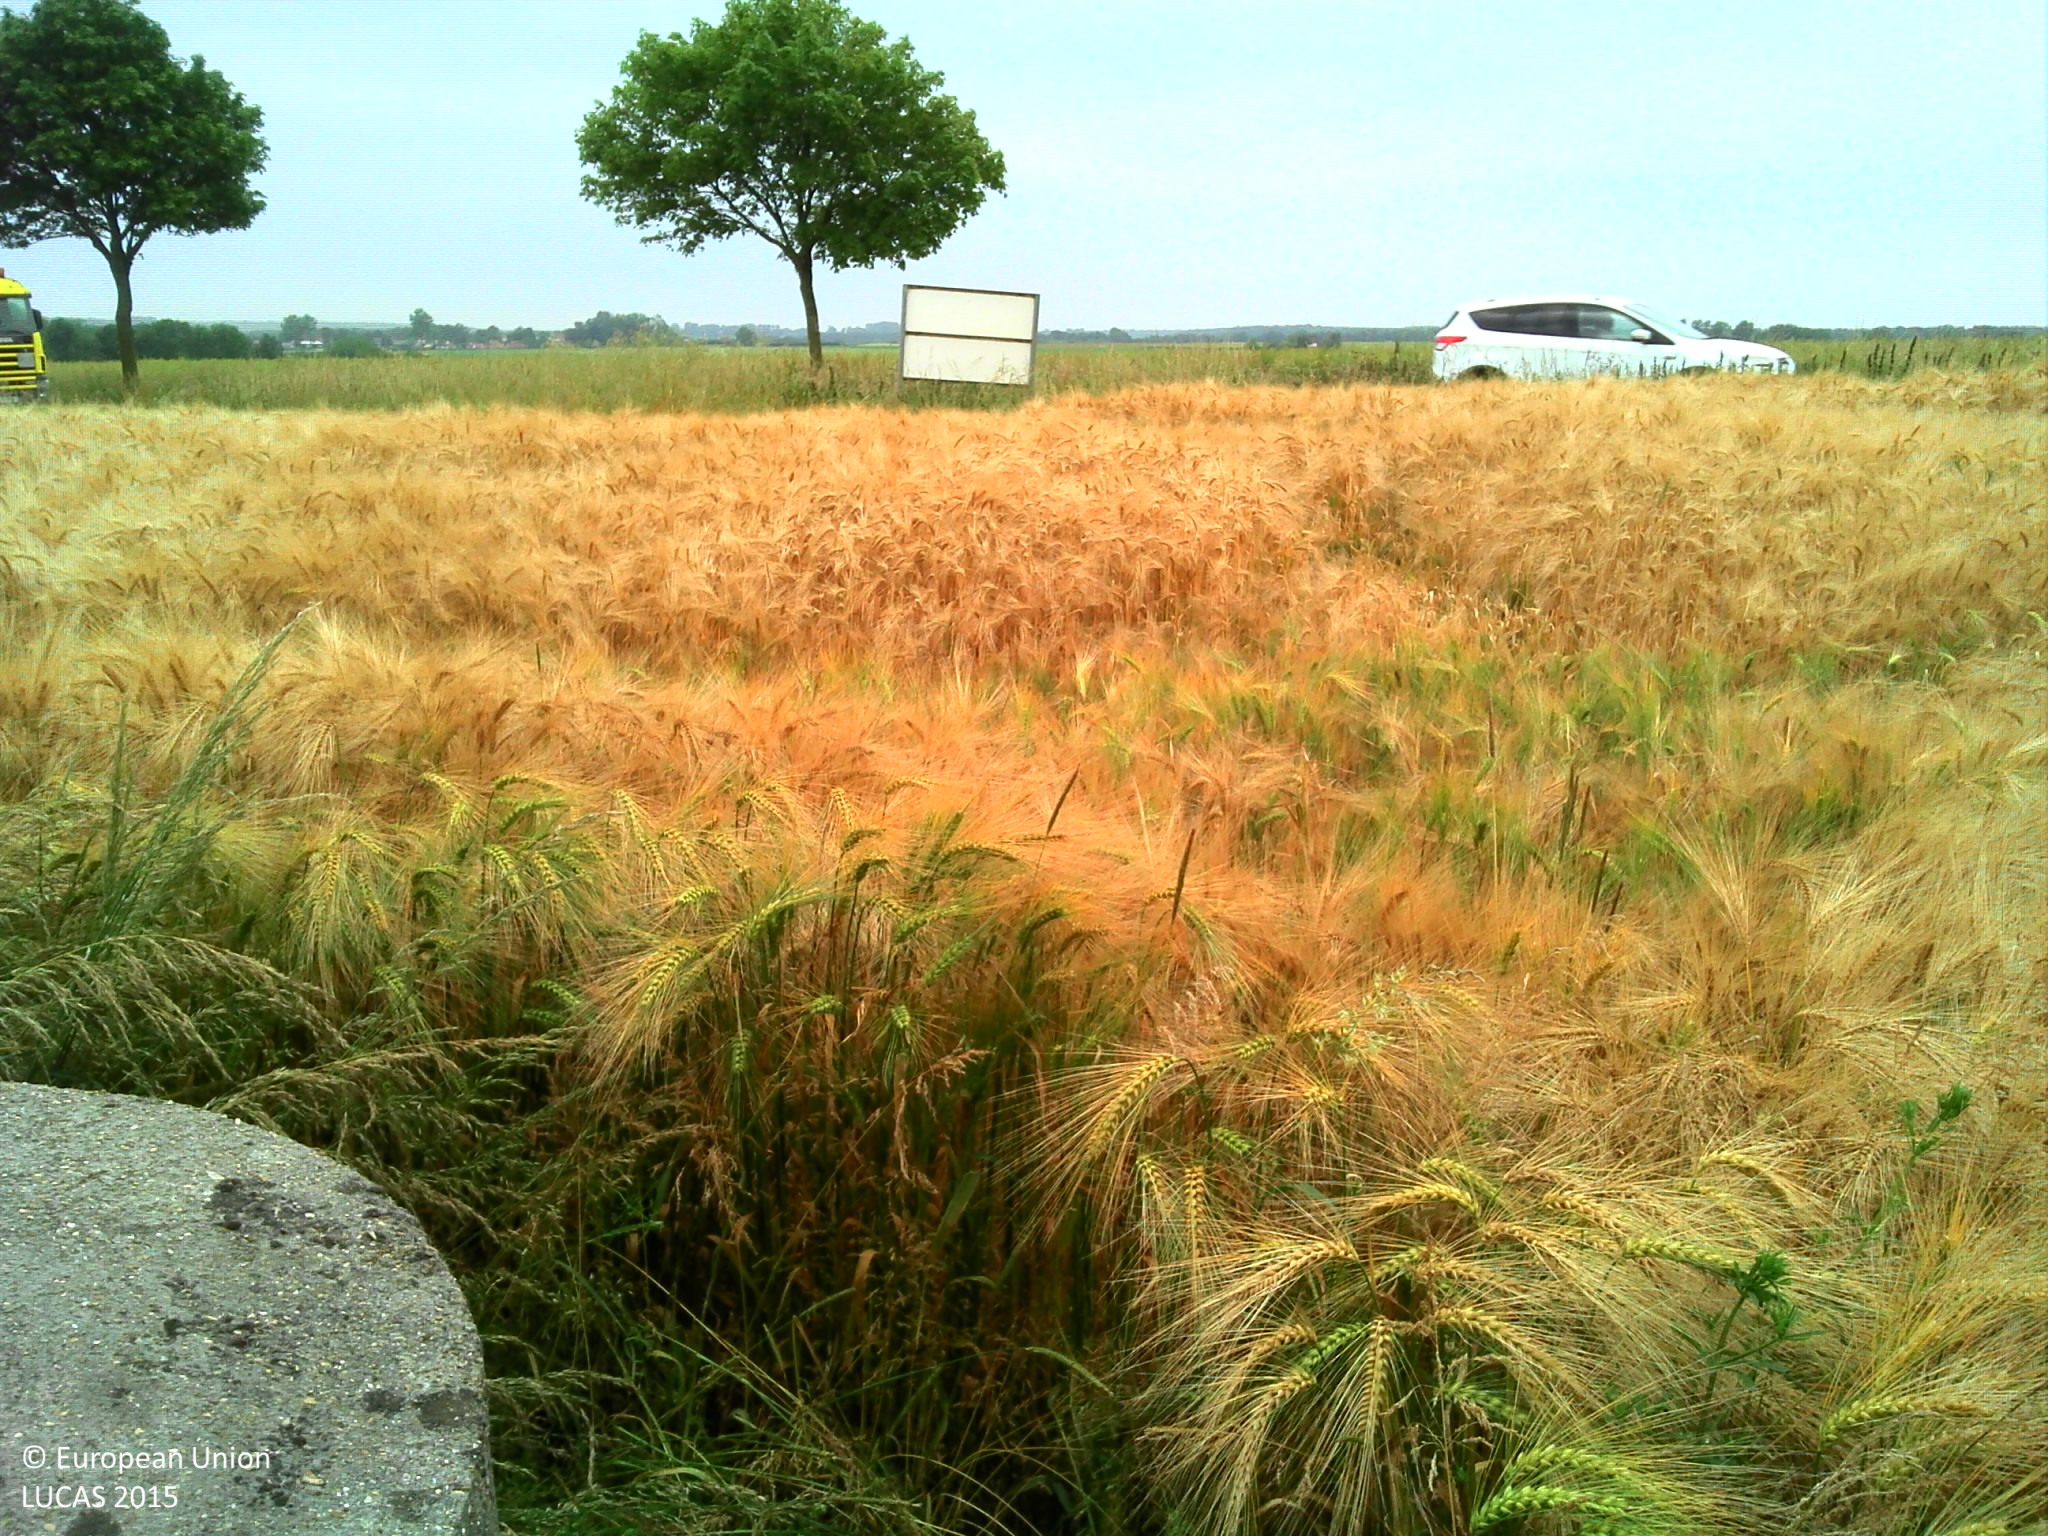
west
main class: Shrubland
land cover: Shrubland without tree cover
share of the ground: > 75 %
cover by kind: herbaceous plants 50 %, shrubs 30 %
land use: Electricity, gas and thermal power distribution
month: July
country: FR
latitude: 50.4706
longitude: 2.1089
